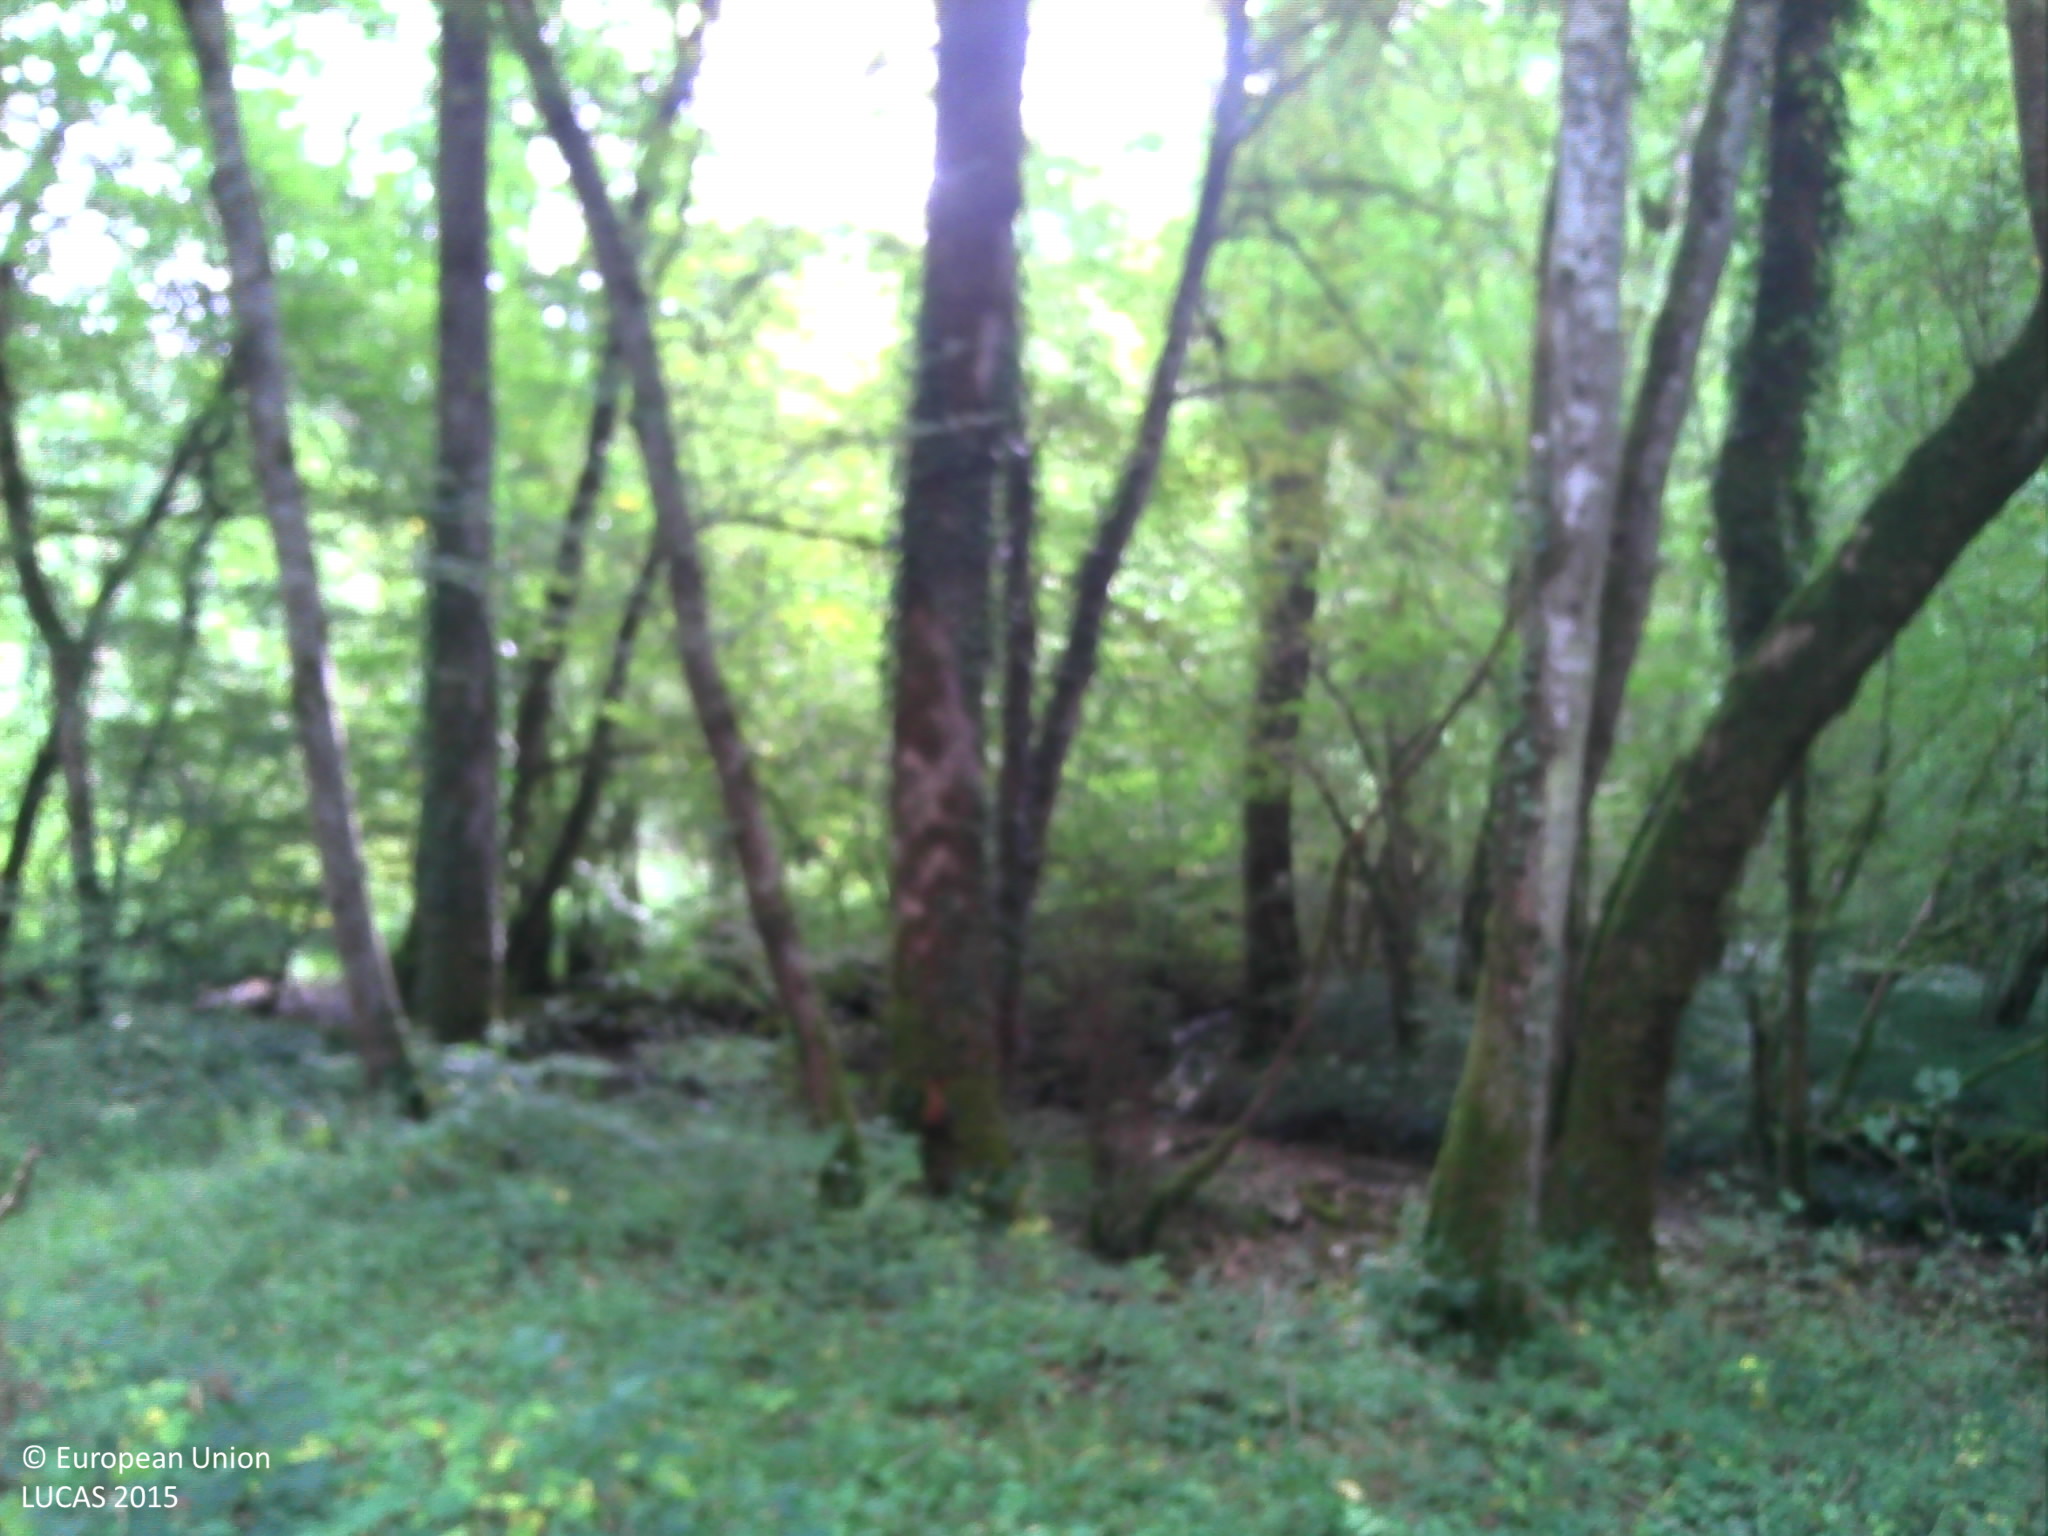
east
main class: Woodland
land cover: Broadleaved woodland
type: mesophytic deciduous forest
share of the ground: > 75 %
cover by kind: broadleaved forest trees 65 %, shrubs 25 %, herbaceous plants 10 %
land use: Forestry
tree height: > 5 m
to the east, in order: Broadleaved woodland; Fences; Grassland without tree/shrub cover; Fences; Grassland without tree/shrub cover; Broadleaved woodland; Tracks; Electric lines; Broadleaved woodland; Rivers and streams; Broadleaved woodland
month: September
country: FR
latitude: 47.3382
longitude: 4.6927
